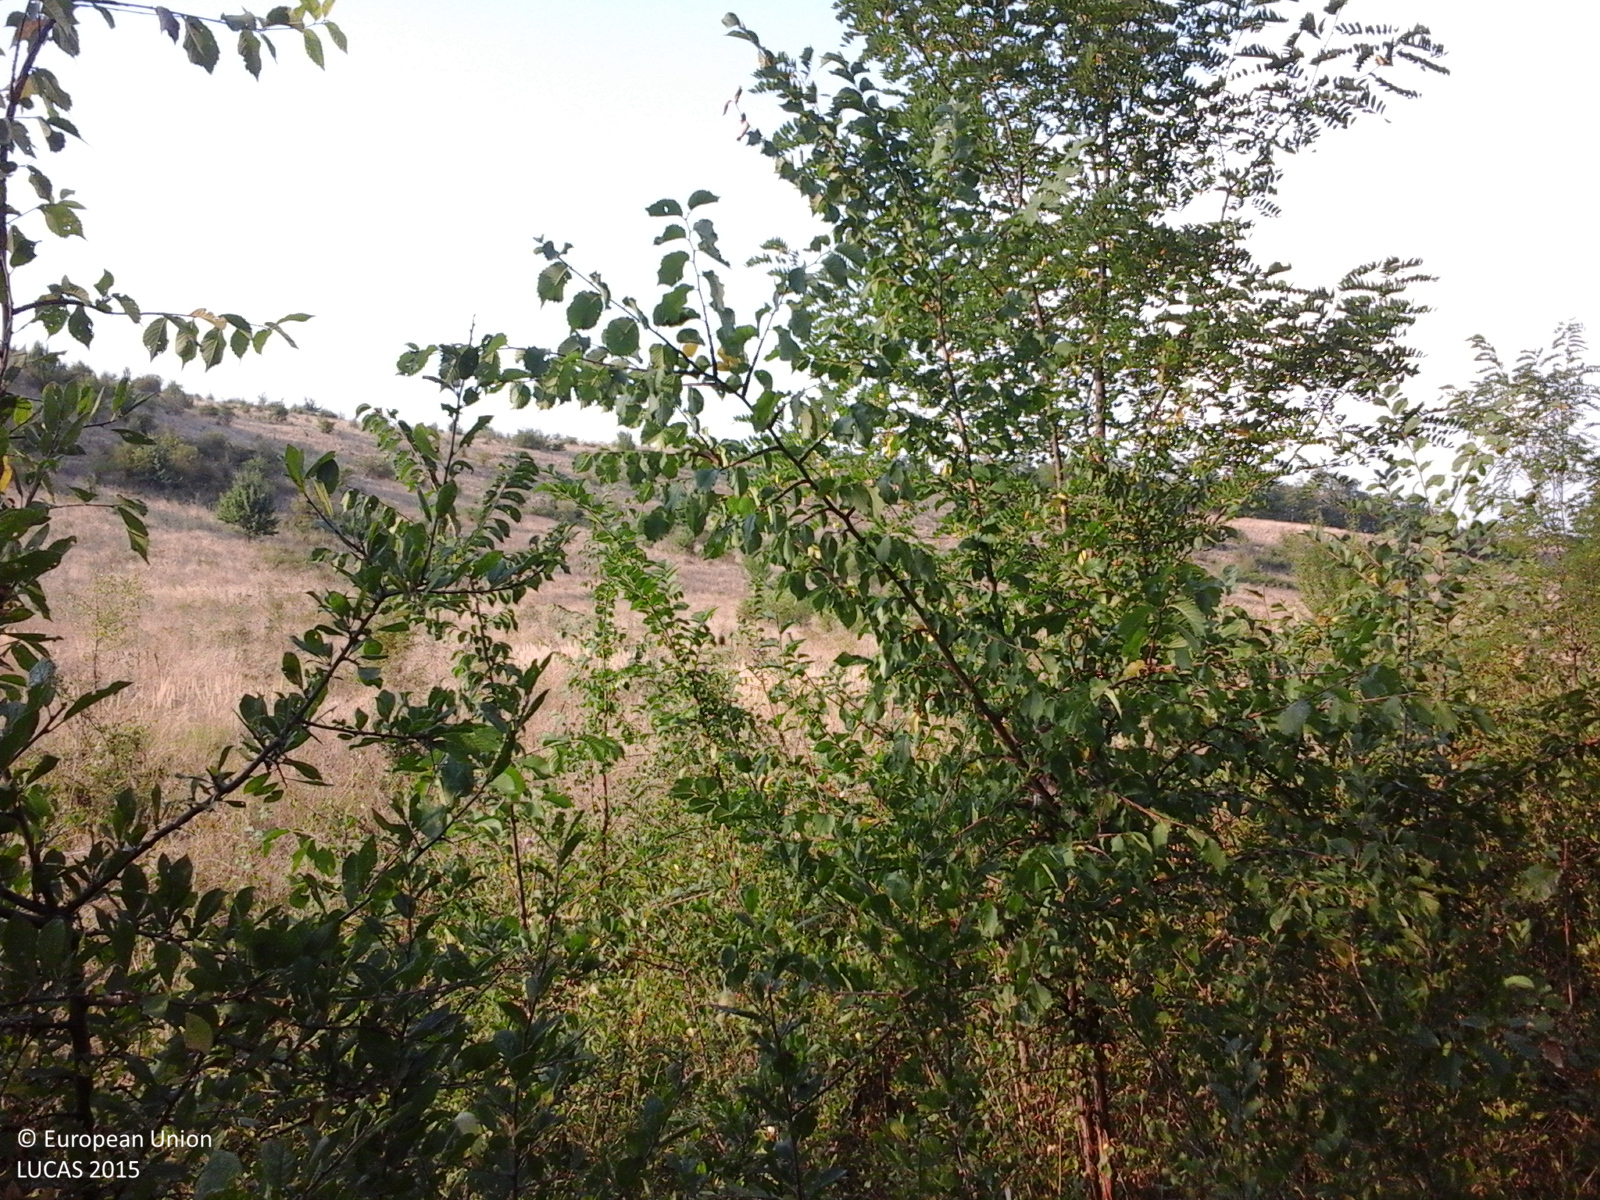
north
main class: Shrubland
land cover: Shrubland with sparse tree cover
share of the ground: > 75 %
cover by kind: shrubs 95 %, broadleaved forest trees 5 %
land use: Semi-natural and natural areas not in use
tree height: < 5 m
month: August
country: RO
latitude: 44.4196
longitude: 23.4531
